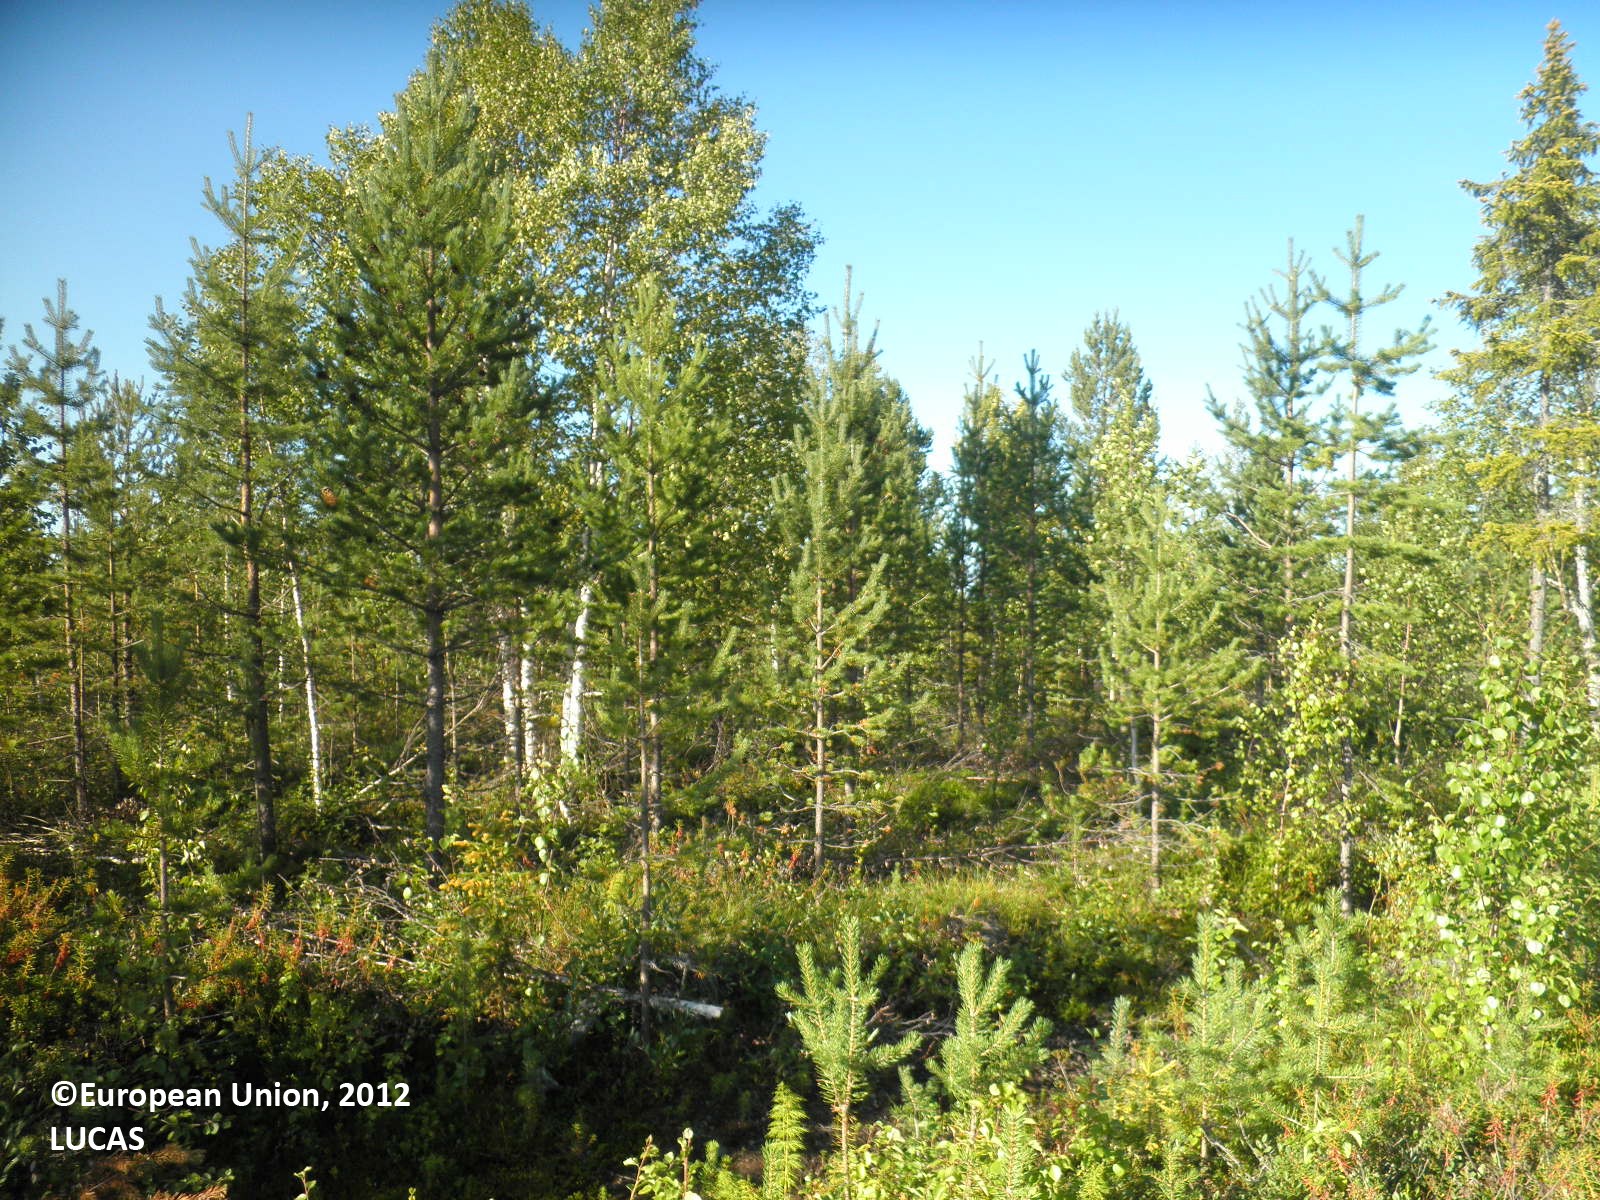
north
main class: Woodland
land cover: Pine dominated mixed woodland
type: boreal forest
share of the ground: 25 - 50 %
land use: Forestry
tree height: < 5 m
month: August
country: FI
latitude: 67.6348
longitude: 27.0630
